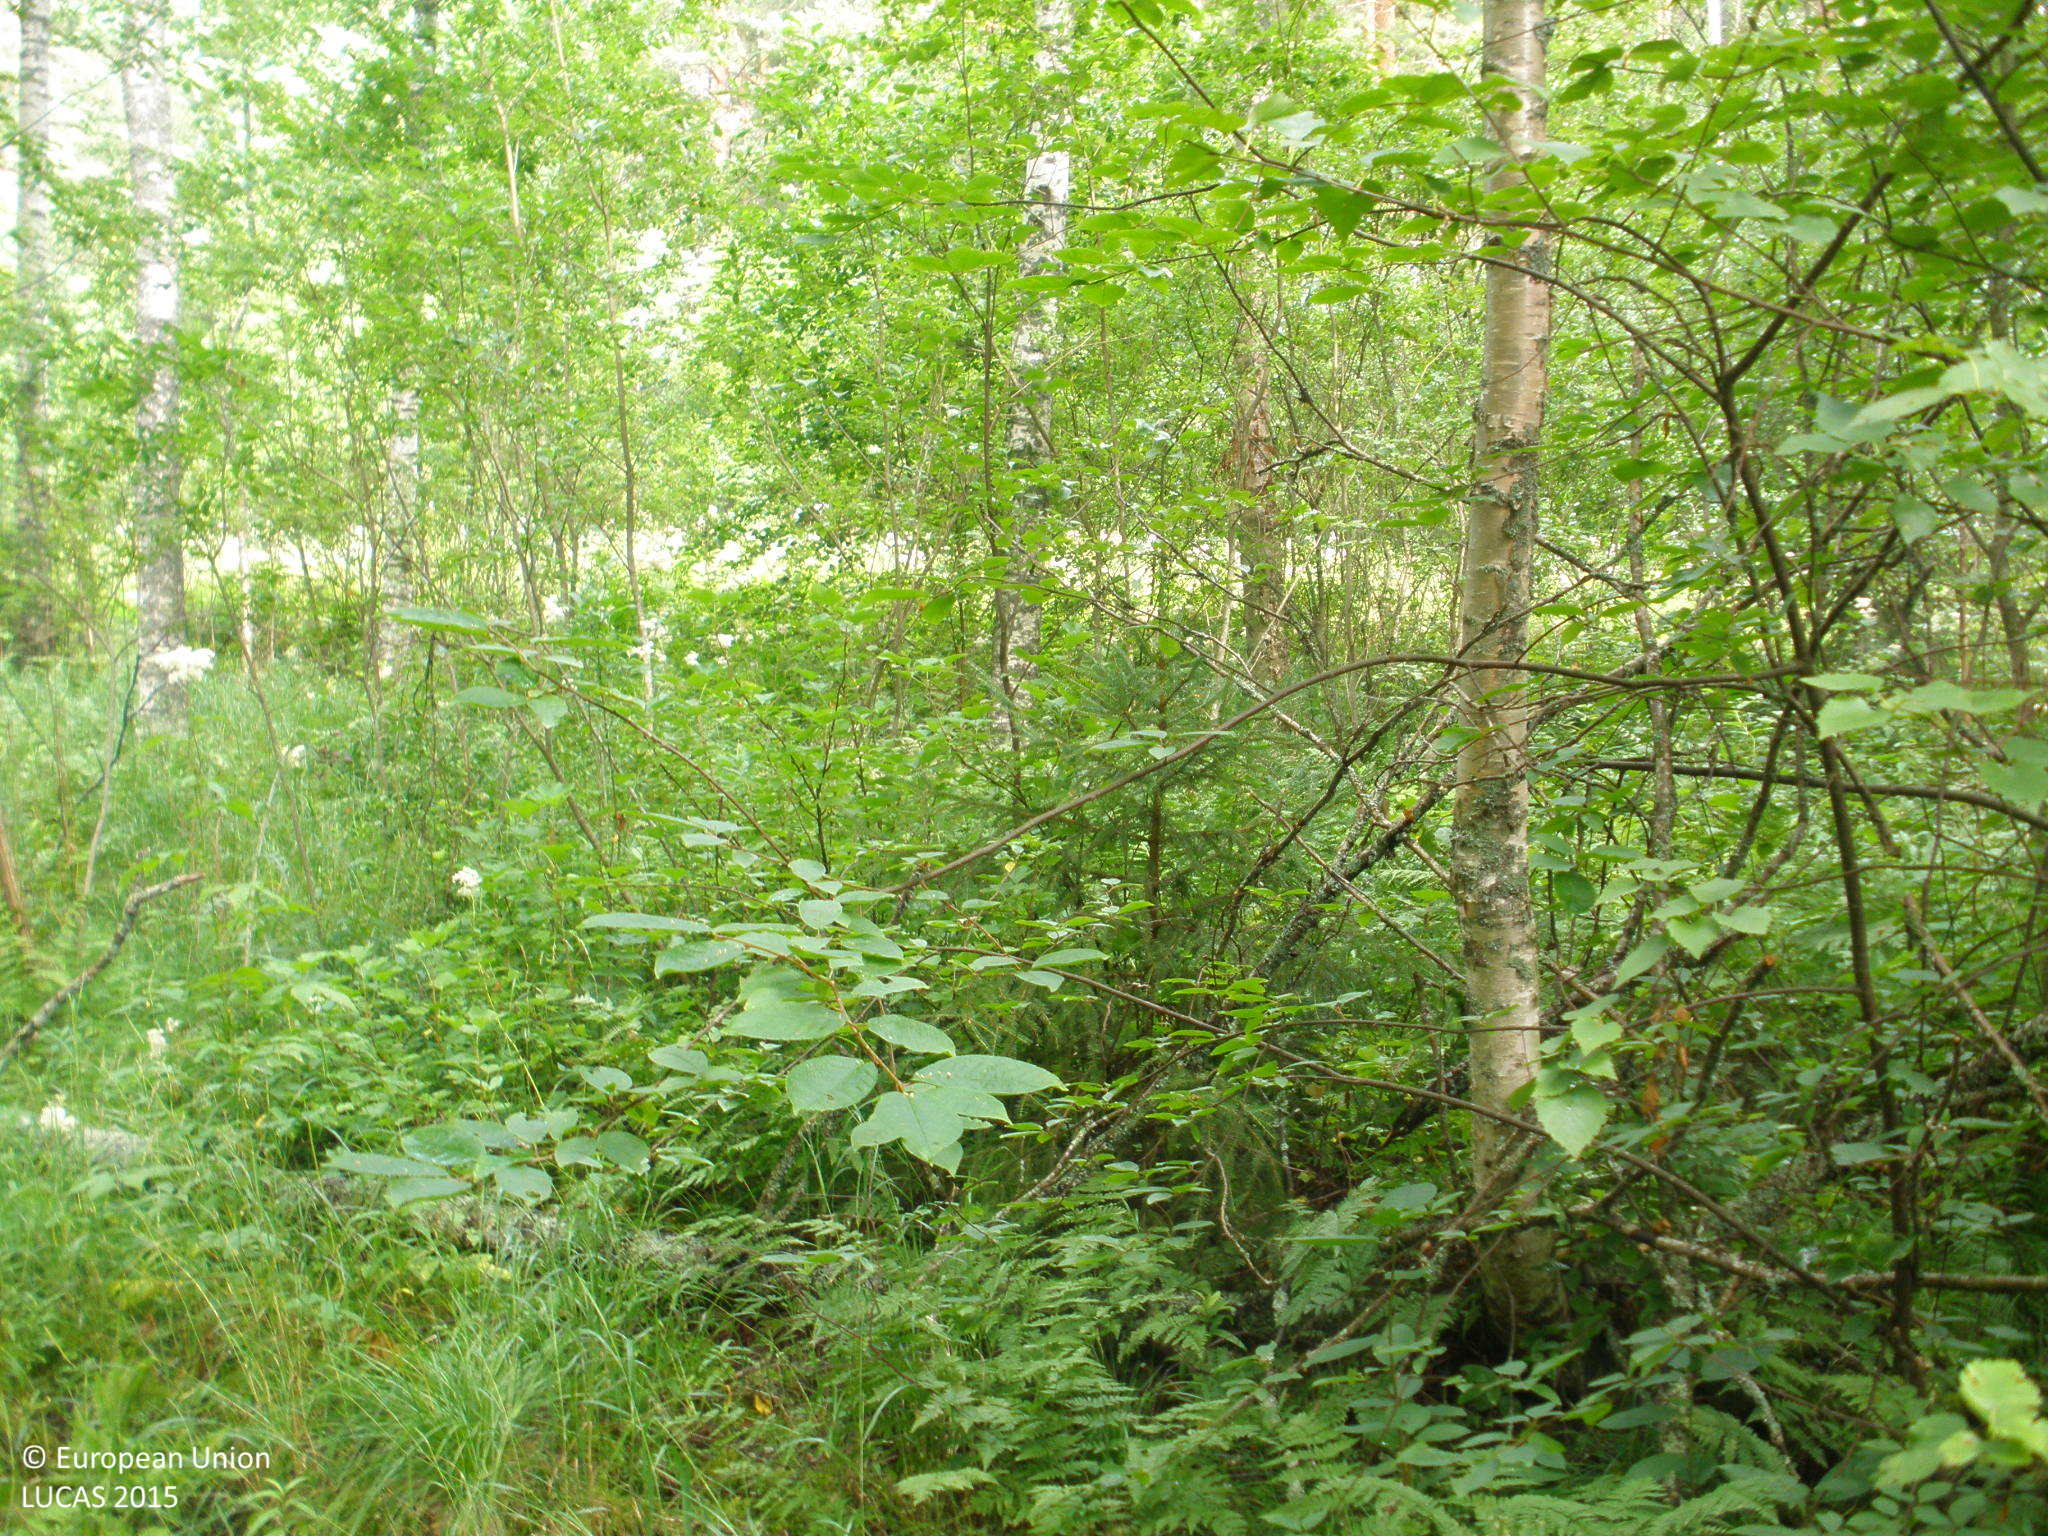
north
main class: Woodland
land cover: Broadleaved woodland
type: boreal forest
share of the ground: > 75 %
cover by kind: broadleaved forest trees 80 %, herbaceous plants 10 %, coniferous forest trees 5 %, shrubs 5 %
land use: Forestry
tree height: > 5 m
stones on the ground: 10 - 25 %
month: July
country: FI
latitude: 61.3298
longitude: 24.7351
